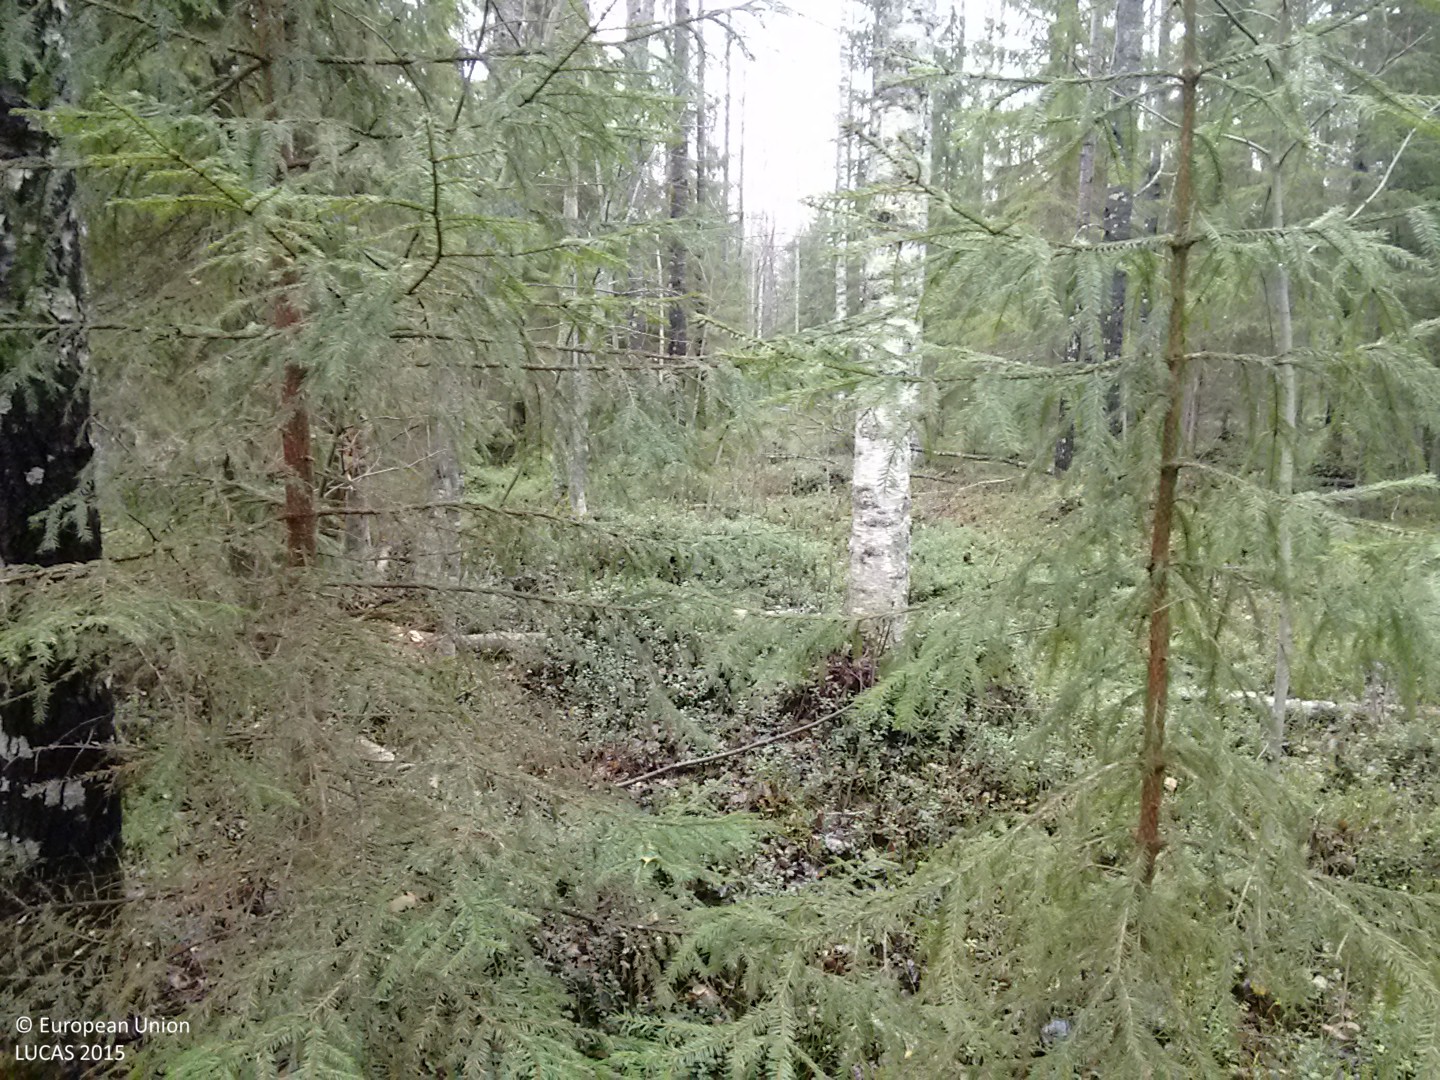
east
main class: Woodland
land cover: Spruce dominated mixed woodland
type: boreal forest
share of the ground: > 75 %
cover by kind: coniferous forest trees 60 %, broadleaved forest trees 25 %, shrubs 15 %
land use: Forestry
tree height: > 5 m
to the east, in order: Spruce dominated mixed woodland; Other mixed woodland; Spruce dominated mixed woodland
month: October
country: FI
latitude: 64.4722
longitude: 25.2034
